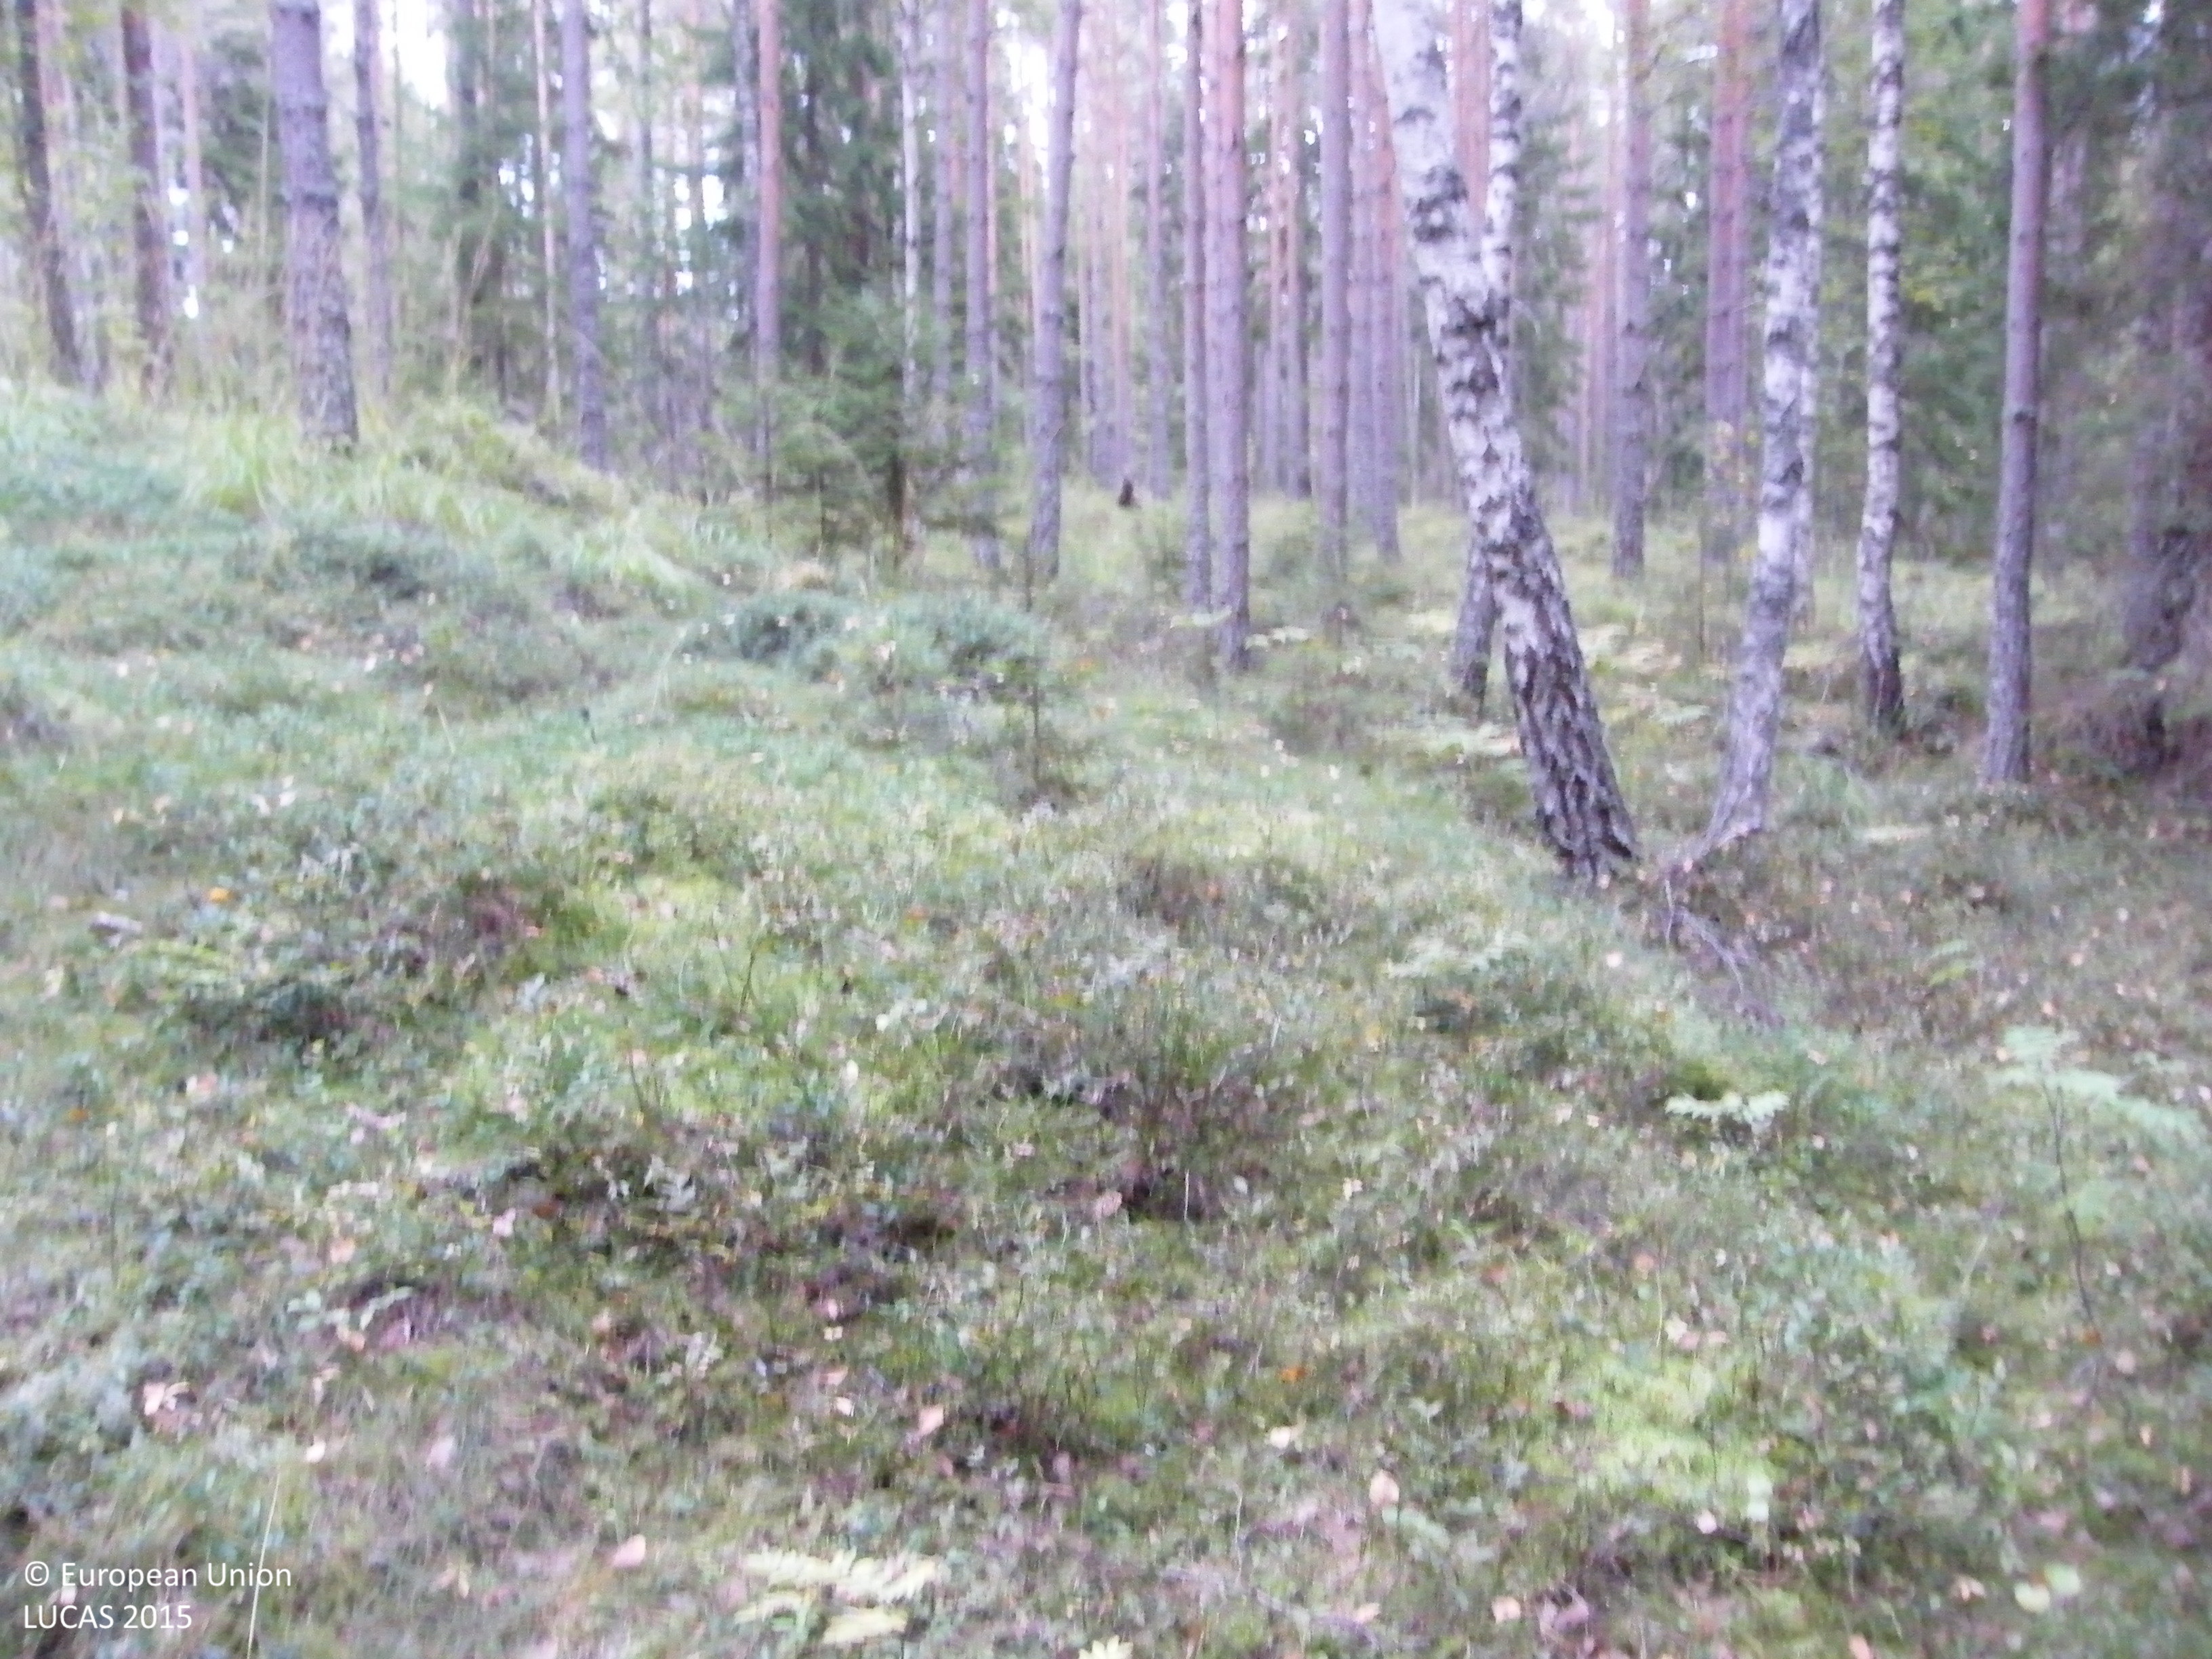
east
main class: Woodland
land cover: Other mixed woodland
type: boreal forest
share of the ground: 50 - 75 %
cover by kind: coniferous forest trees 45 %, broadleaved forest trees 20 %, shrubs 20 %, lichens and mosses 15 %
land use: Forestry
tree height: > 5 m
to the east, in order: Other mixed woodland; Other coniferous woodland; Other mixed woodland; Tracks; Other mixed woodland
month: September
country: SE
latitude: 59.7311
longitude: 15.4862
